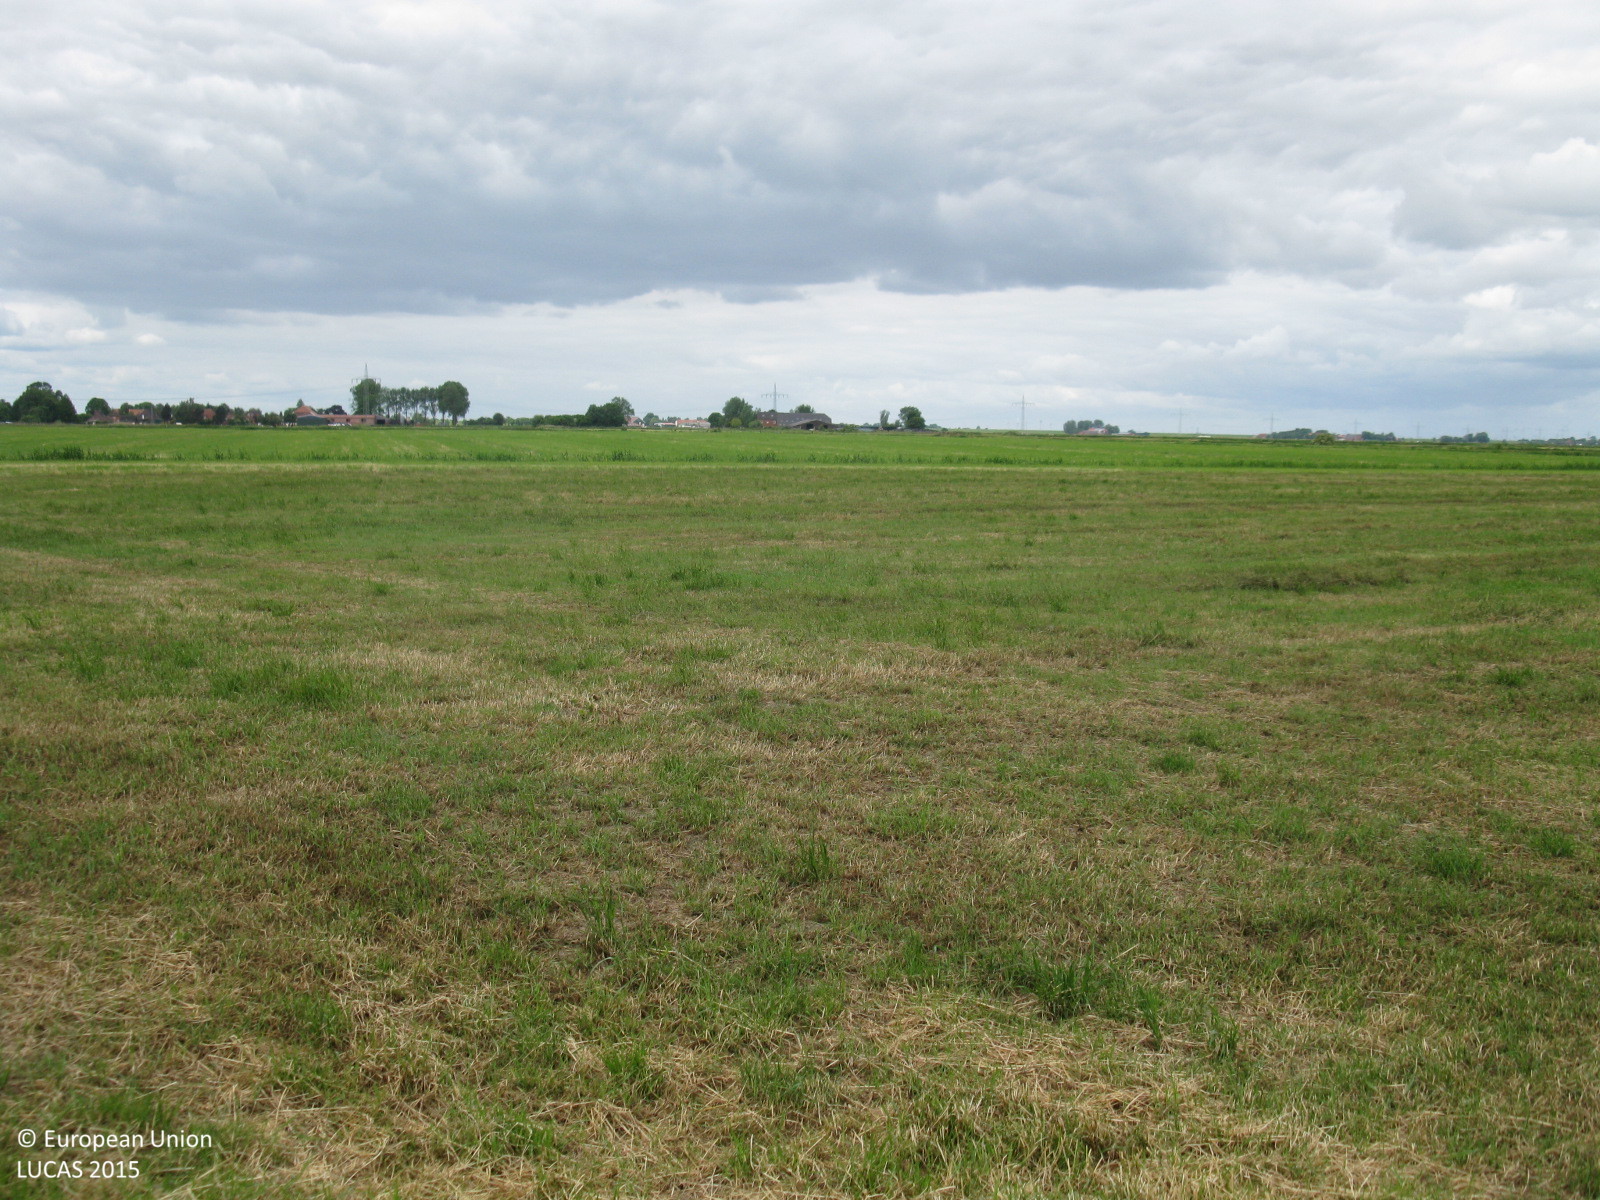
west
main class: Grassland
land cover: Grassland without tree/shrub cover
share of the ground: > 75 %
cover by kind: herbaceous plants 100 %
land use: Agriculture (excluding fallow land and kitchen gardens)
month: June
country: DE
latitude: 53.3022
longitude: 7.4046
